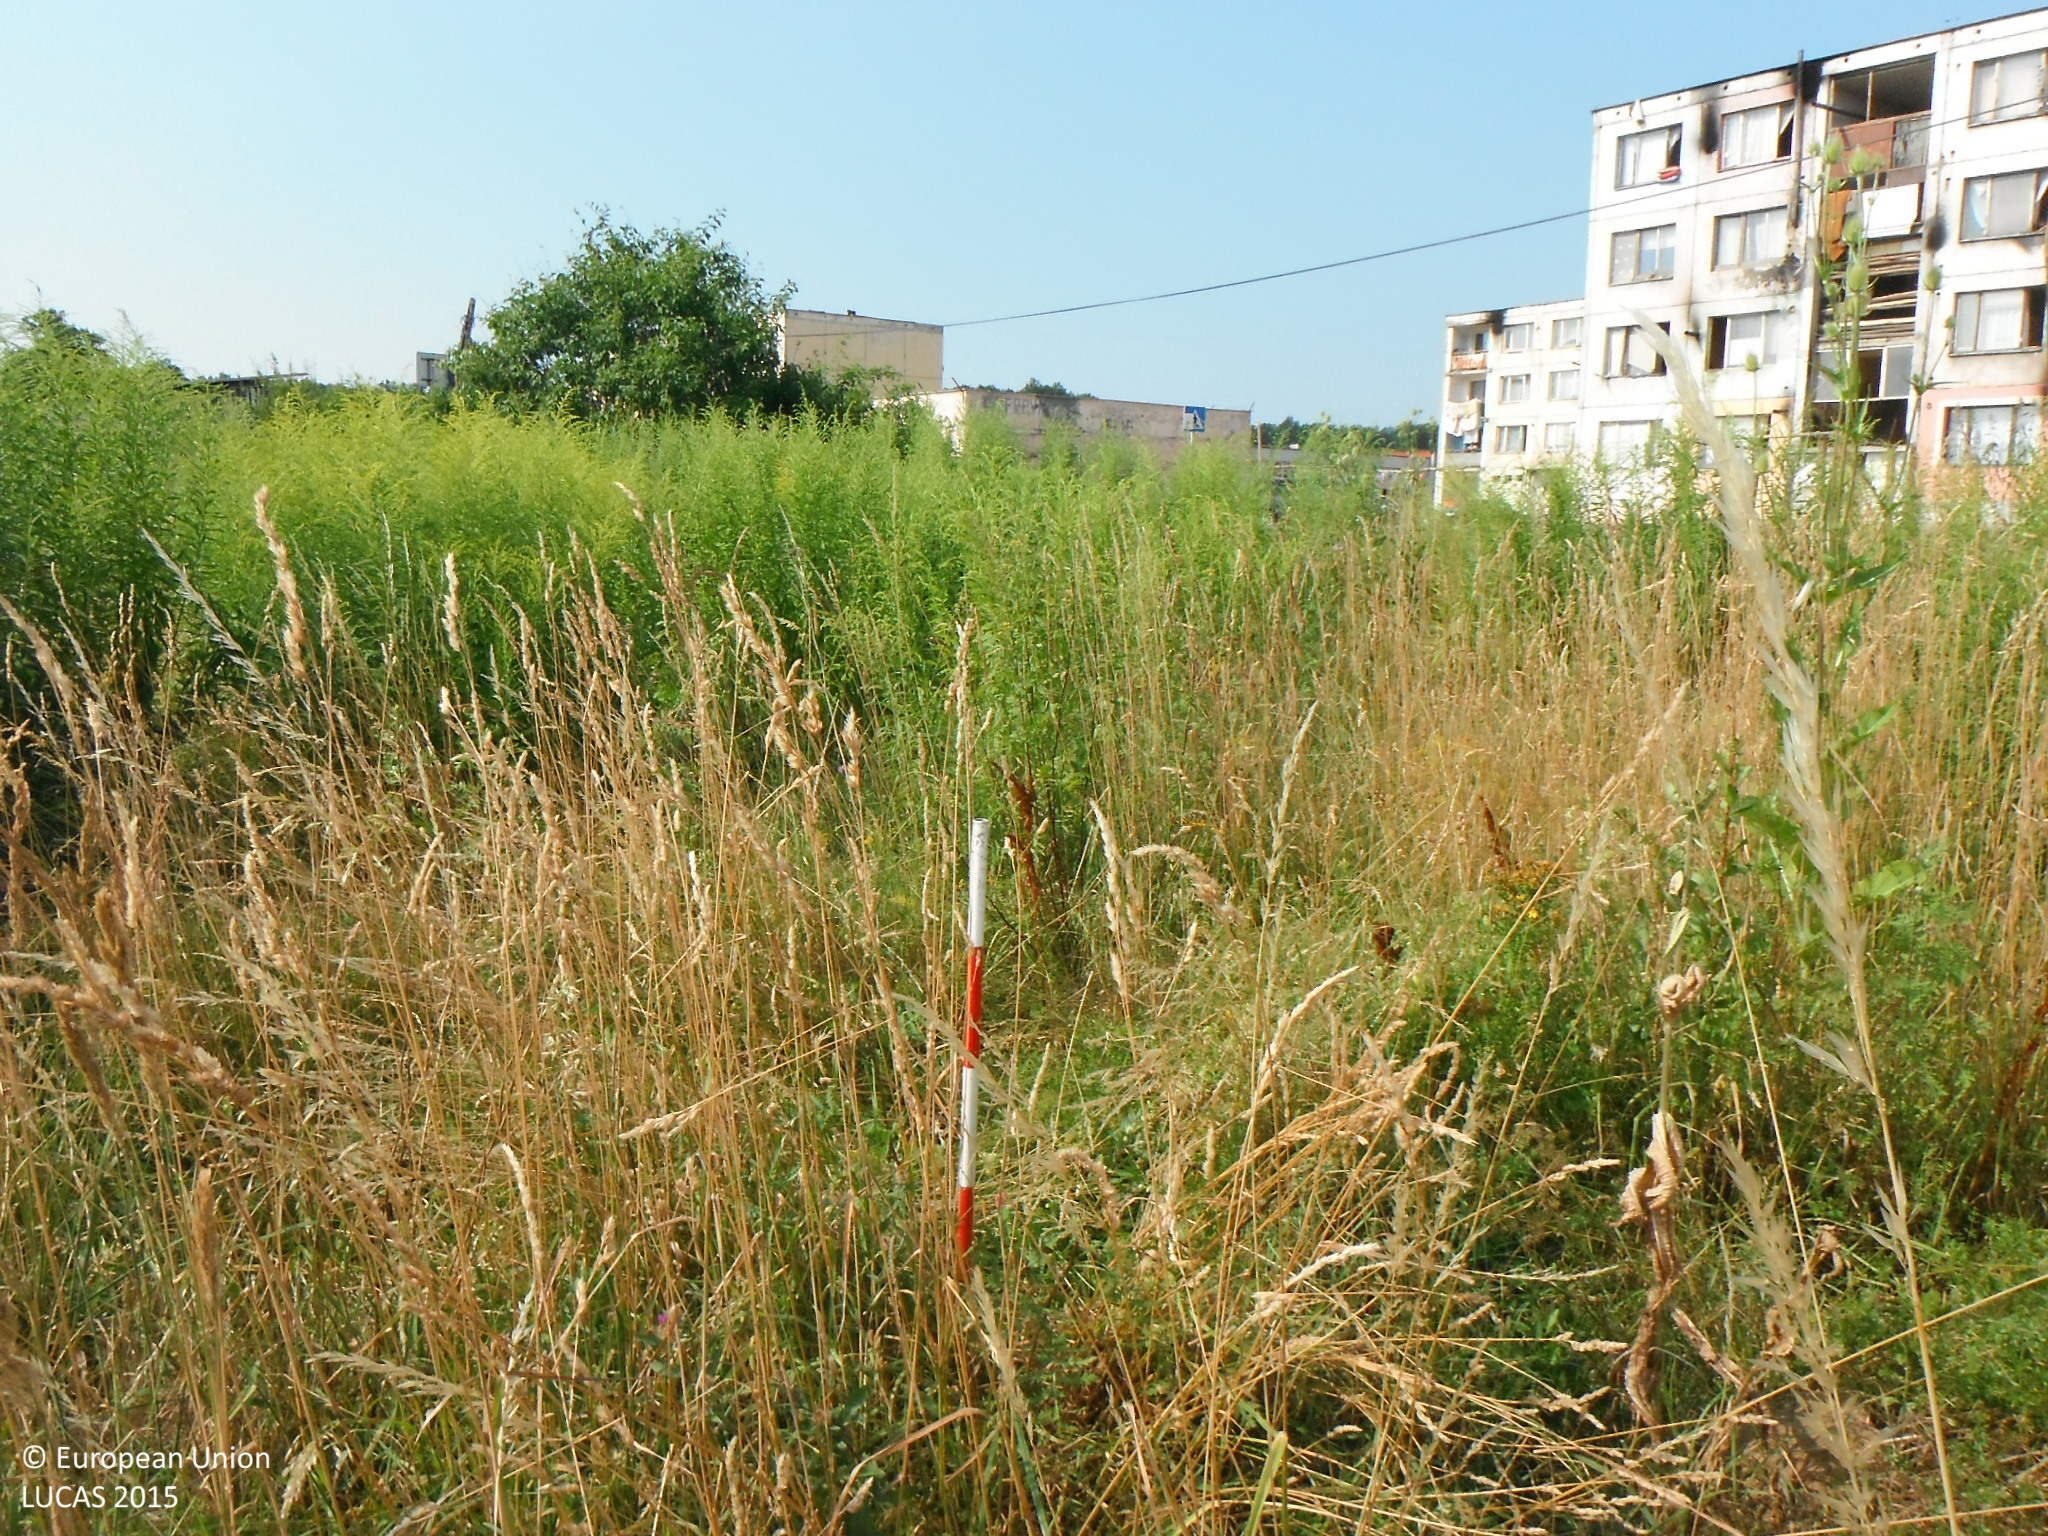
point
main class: Grassland
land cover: Spontaneously vegetated surfaces
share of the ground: > 75 %
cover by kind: herbaceous plants 100 %
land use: Semi-natural and natural areas not in use
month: July
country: SK
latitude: 48.3656
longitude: 20.0043
